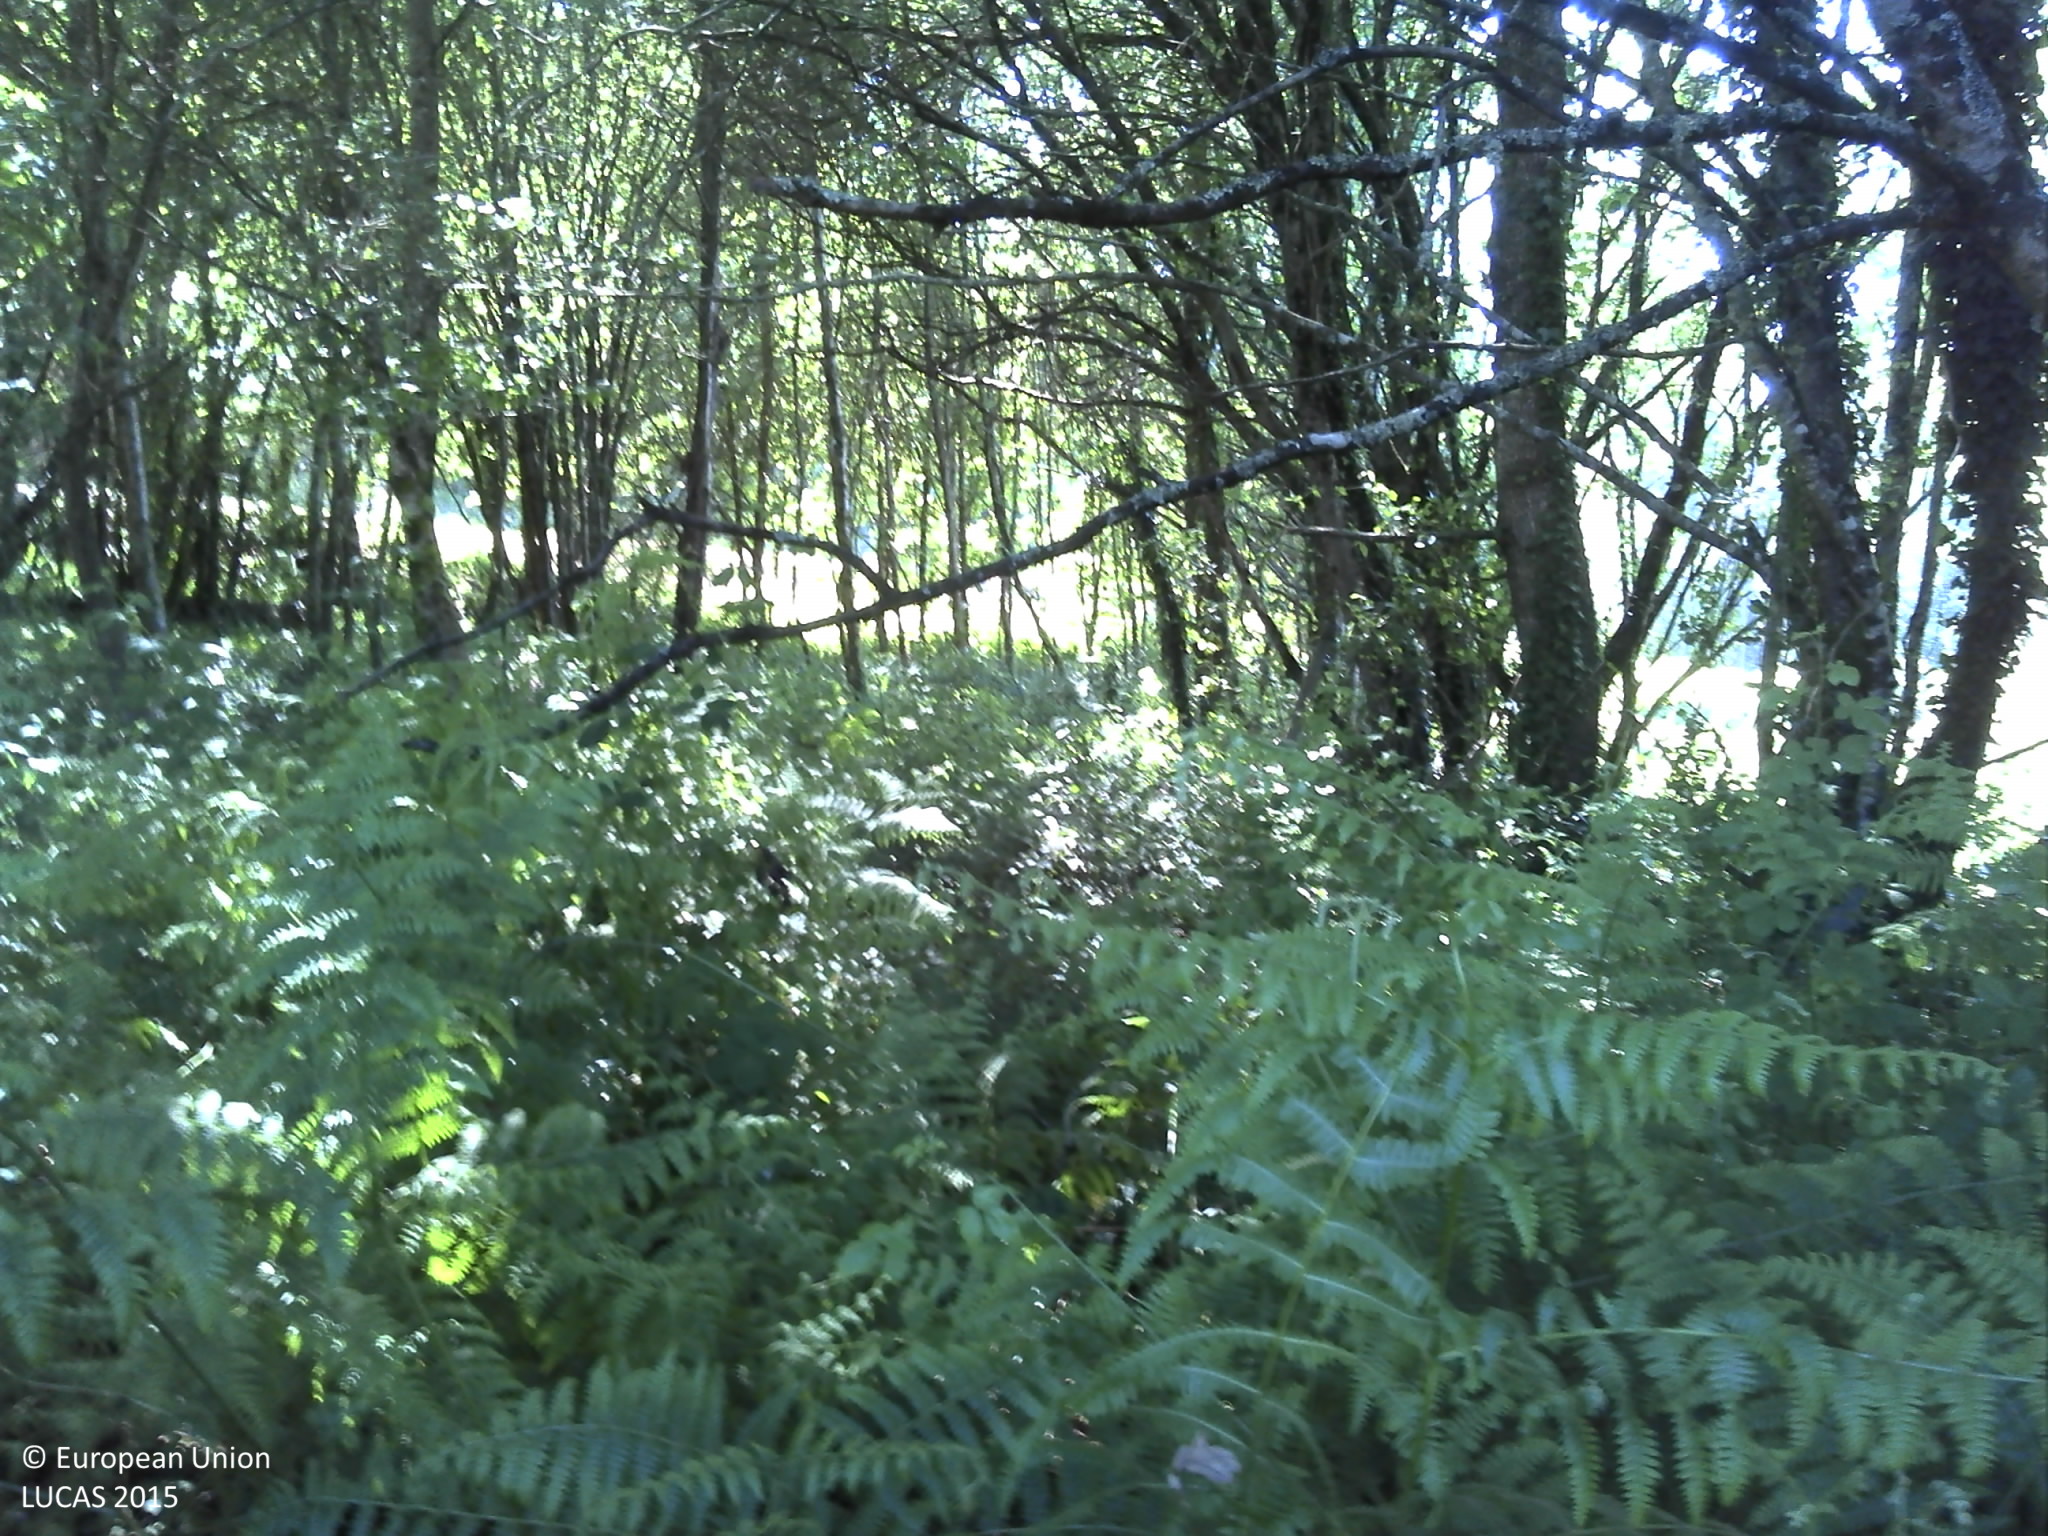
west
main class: Woodland
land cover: Broadleaved woodland
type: thermophilous deciduous forest
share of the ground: > 75 %
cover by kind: broadleaved forest trees 85 %, shrubs 15 %
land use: Forestry
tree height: > 5 m
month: May
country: PT
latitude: 41.9505
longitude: -8.6857
